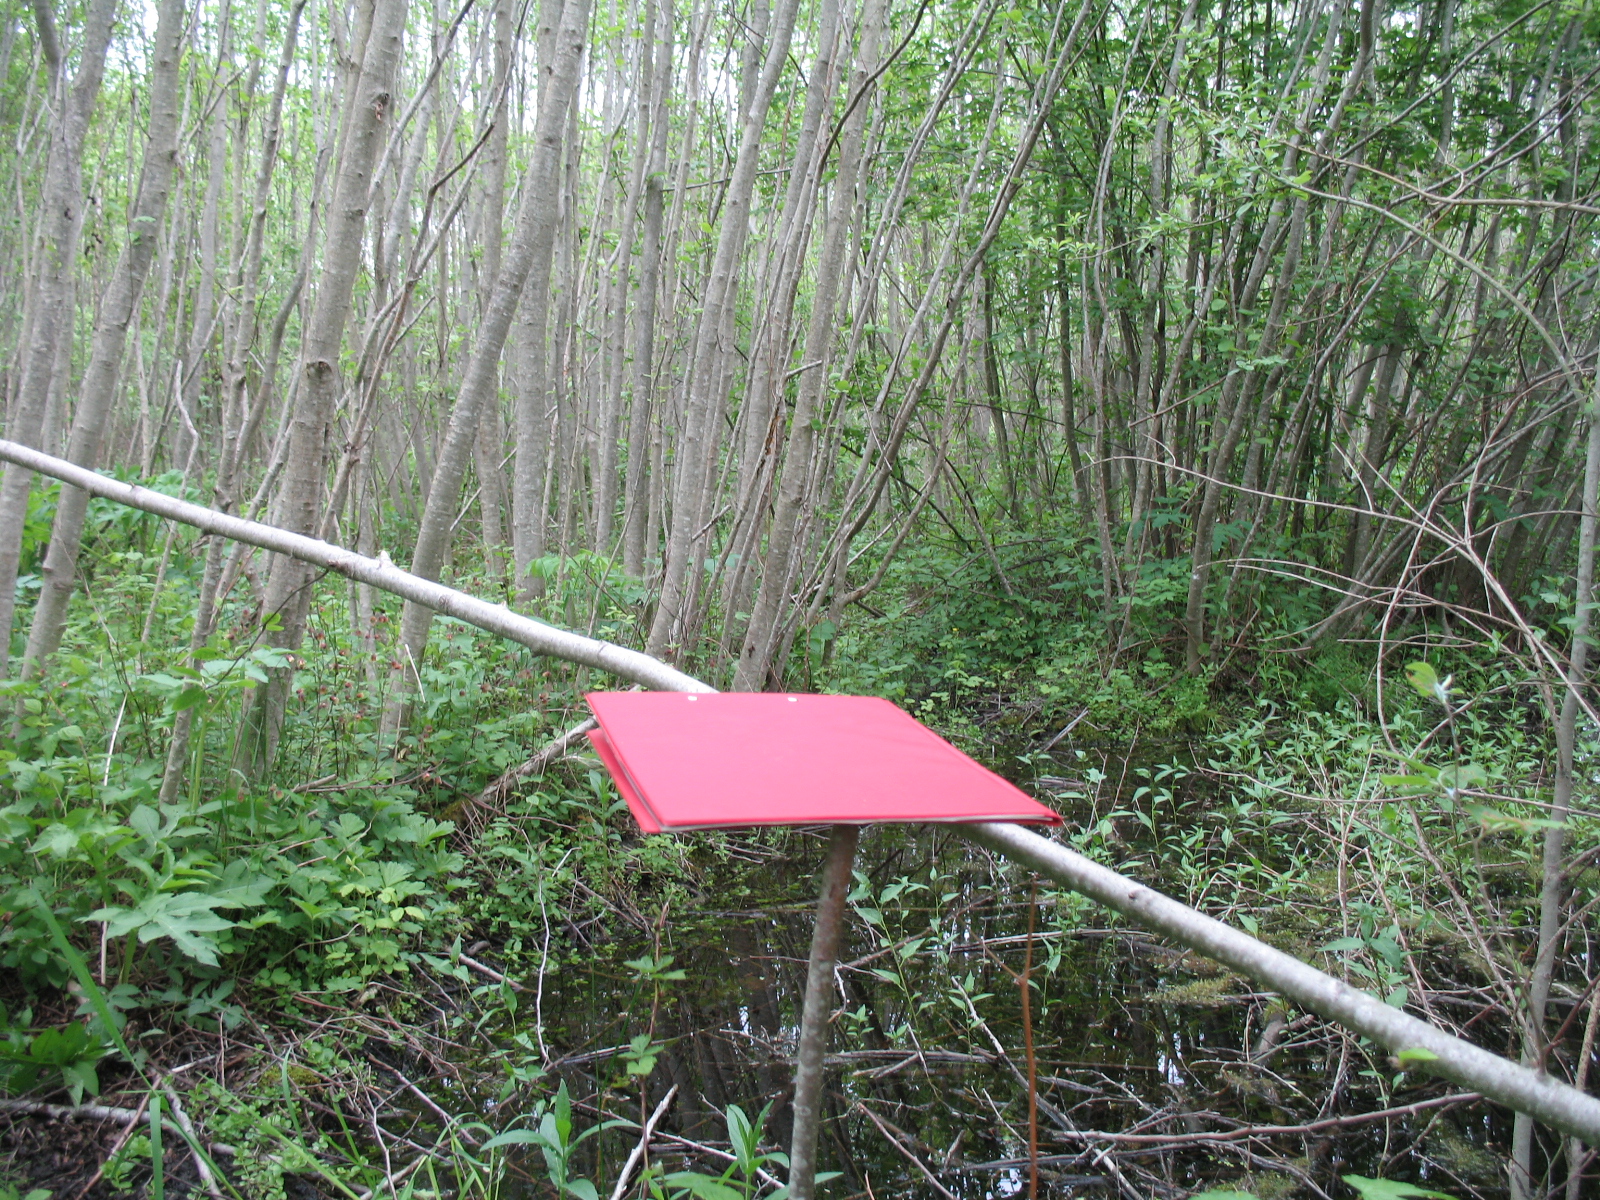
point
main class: Woodland
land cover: Broadleaved woodland
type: mire and swamp forests
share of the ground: > 75 %
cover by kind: broadleaved forest trees 95 %, herbaceous plants 5 %
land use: Forestry
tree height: > 5 m
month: May
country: LV
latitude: 56.7451
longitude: 23.5315
